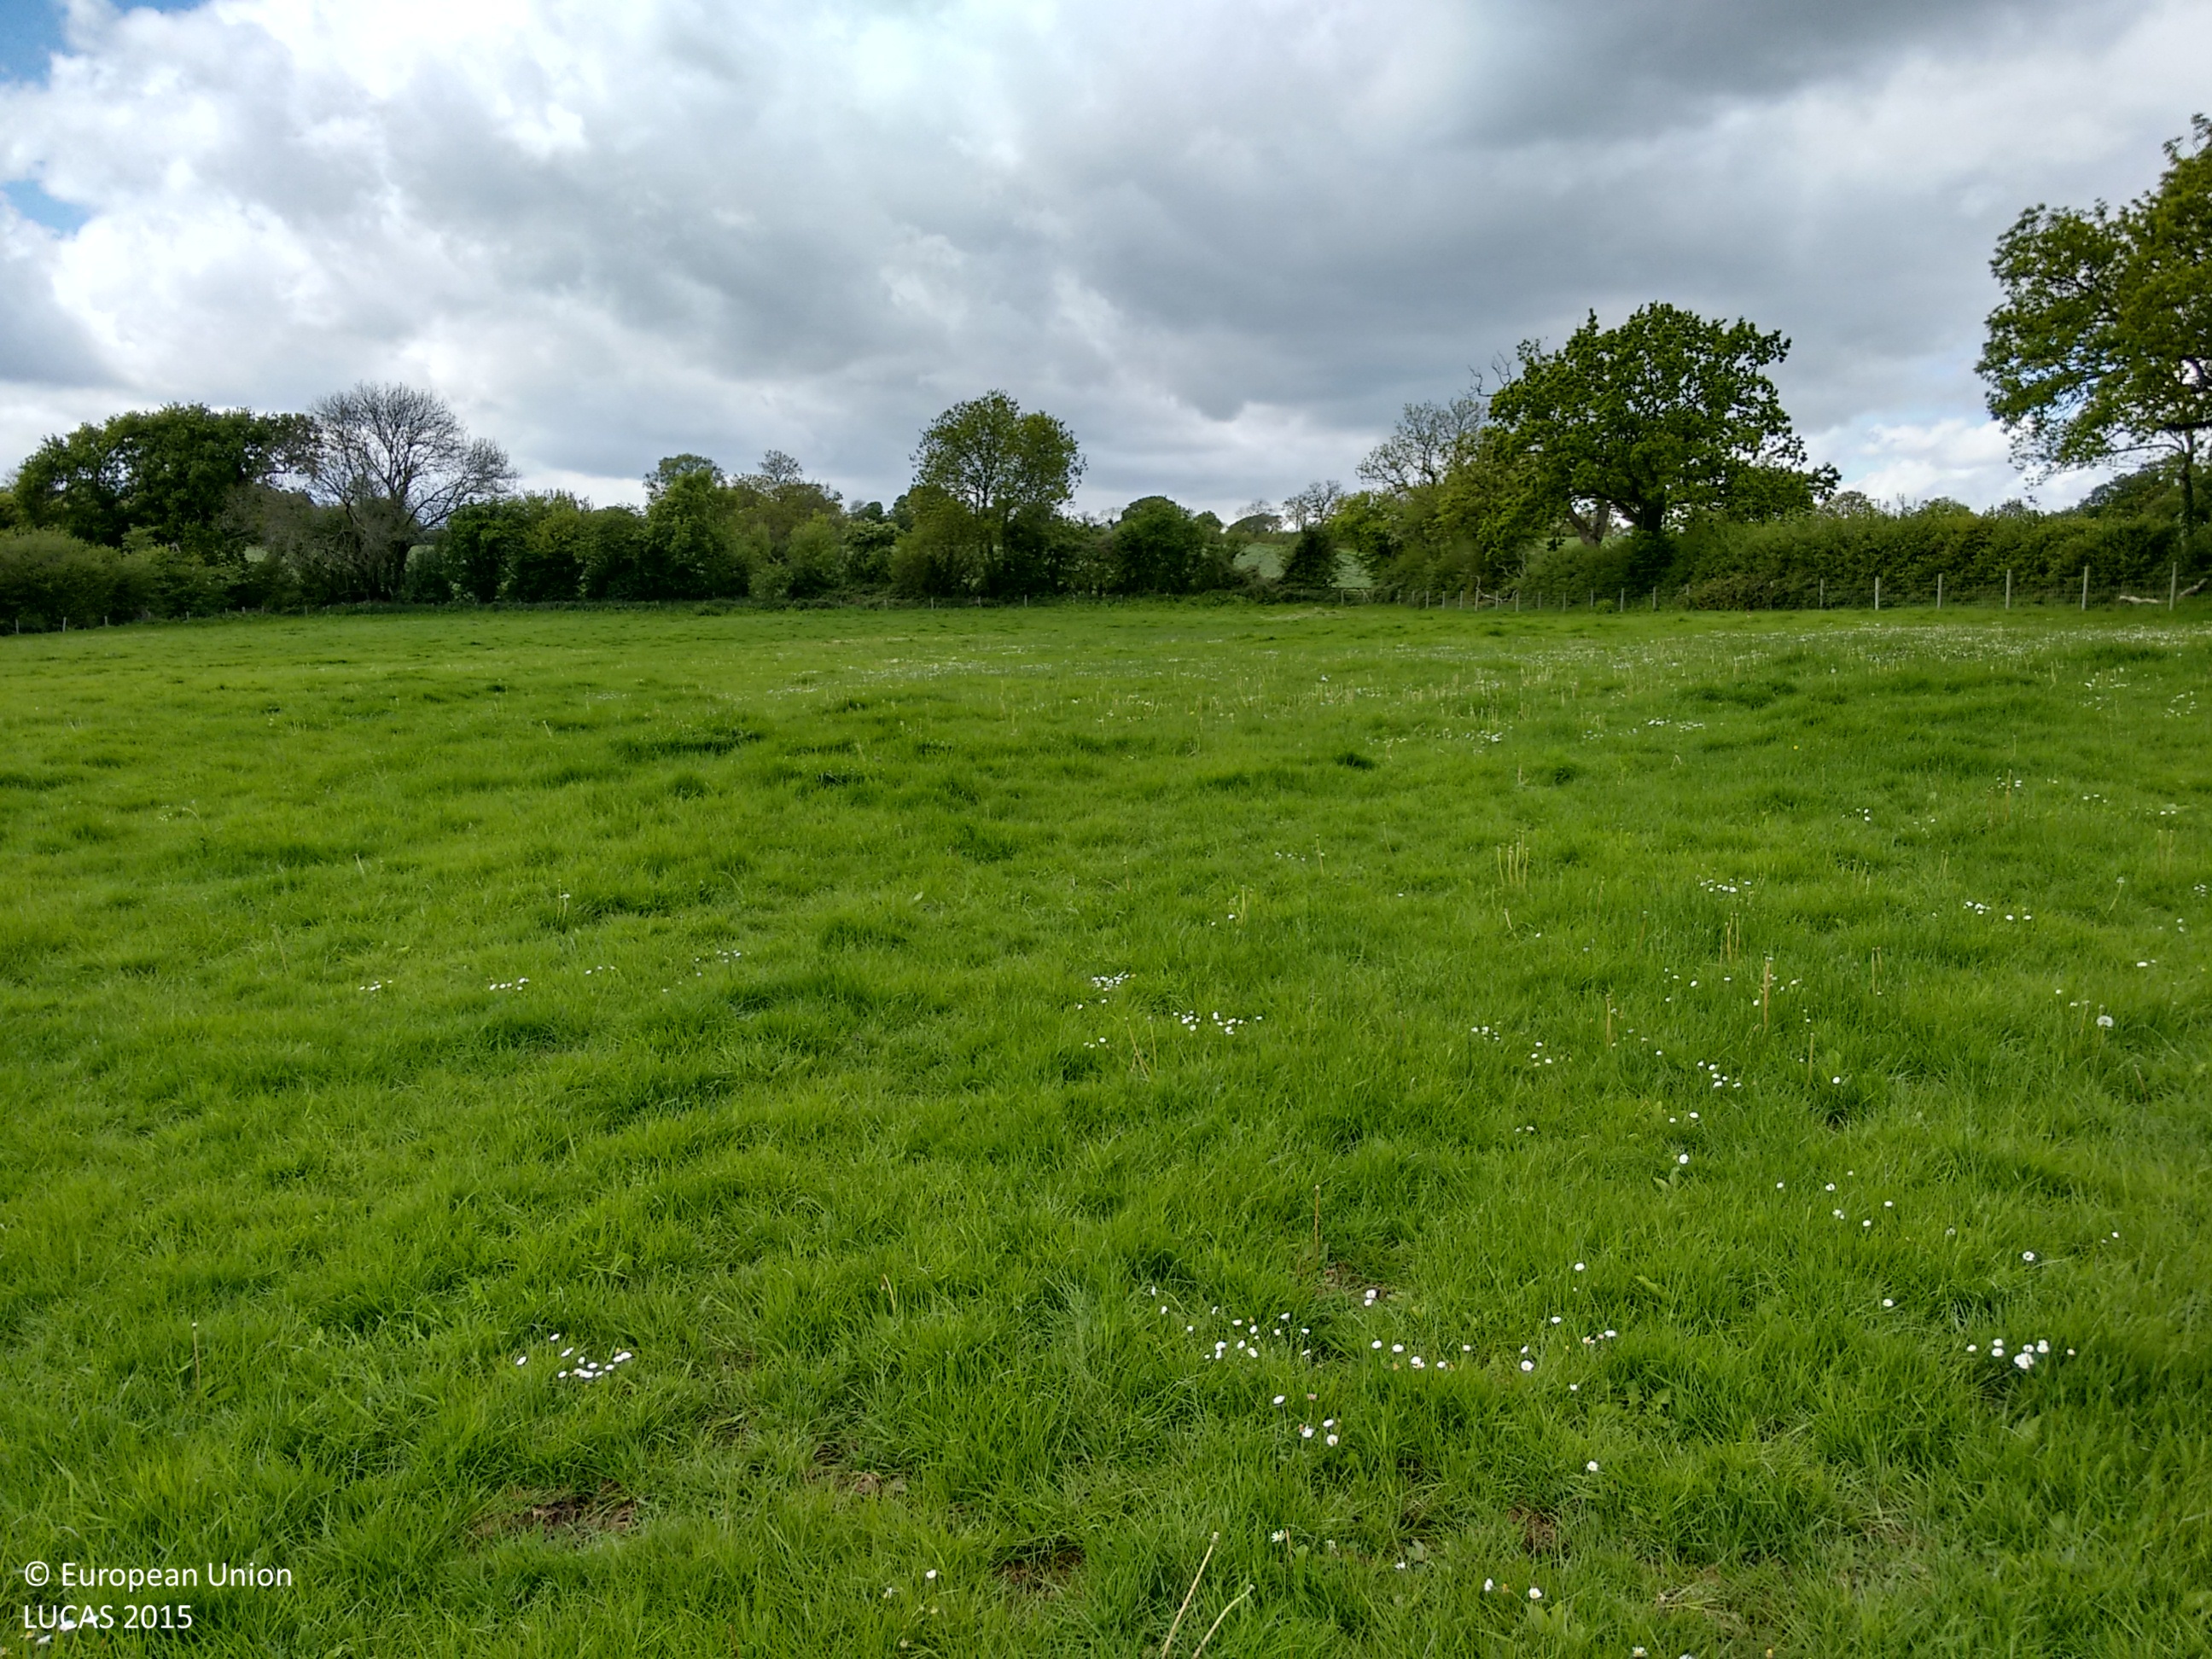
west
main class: Grassland
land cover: Grassland without tree/shrub cover
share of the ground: > 75 %
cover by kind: herbaceous plants 100 %
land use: Agriculture (excluding fallow land and kitchen gardens)
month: May
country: GB
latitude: 50.9383
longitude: -2.4317
